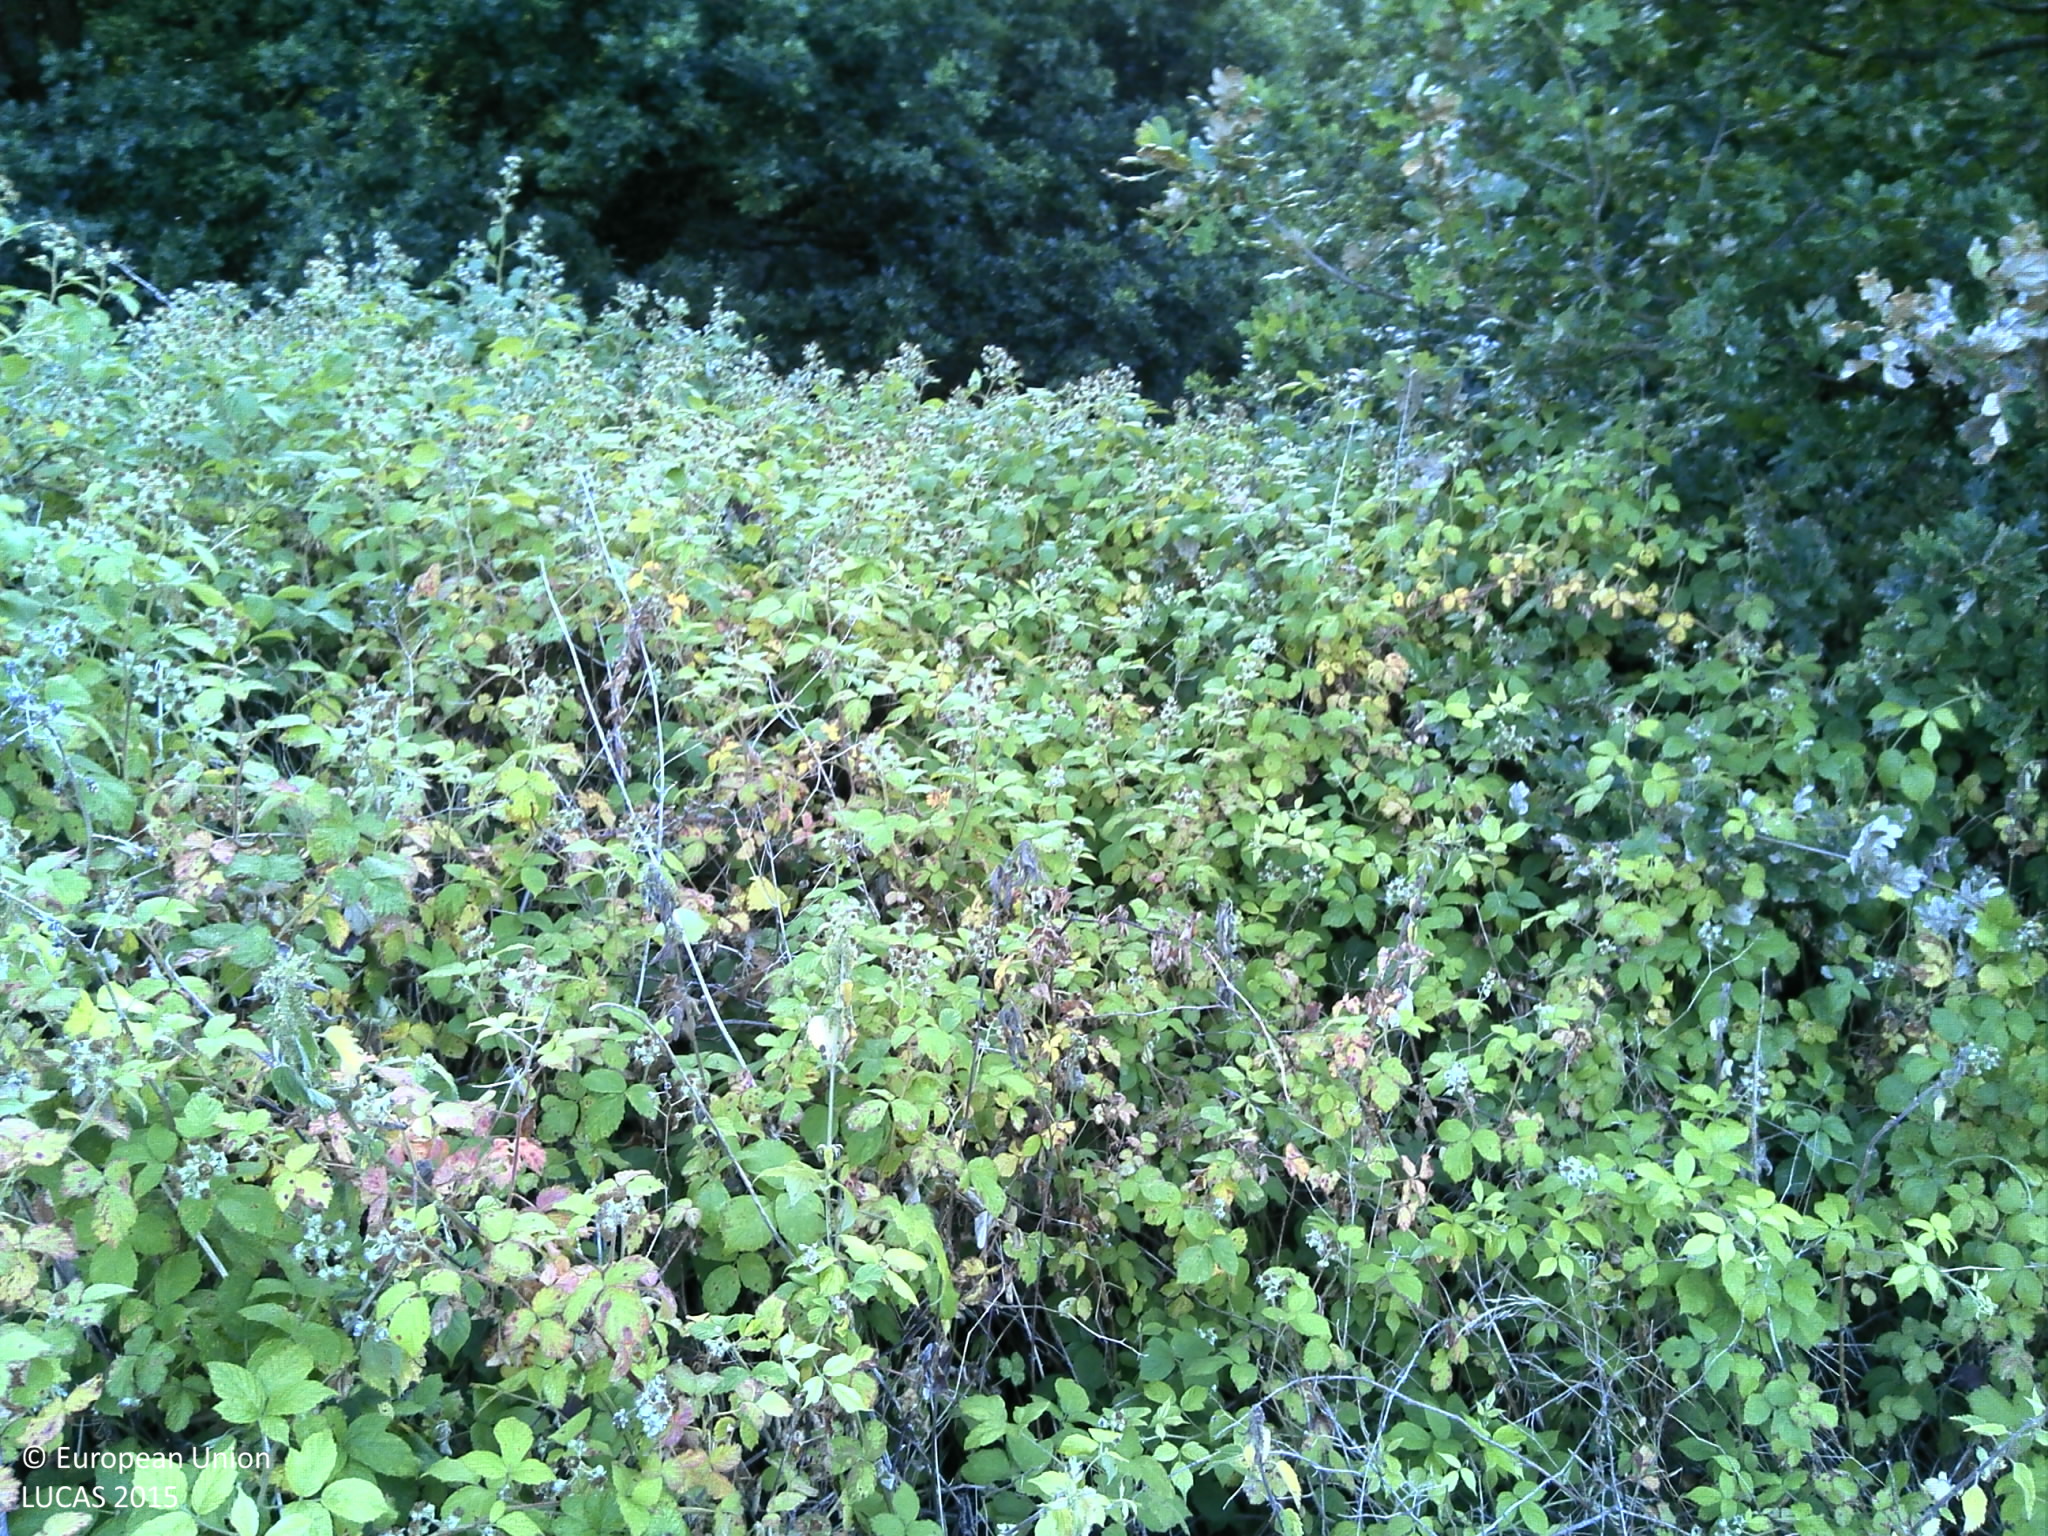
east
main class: Woodland
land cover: Broadleaved woodland
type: acidophilous oak and oak-birch forest
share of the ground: > 75 %
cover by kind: broadleaved forest trees 100 %
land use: Forestry
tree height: > 5 m
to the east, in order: Broadleaved woodland; Paved roads, cycling and walking lanes; Broadleaved woodland; Fences; Broadleaved woodland; Fences; Paved roads, cycling and walking lanes; Grass margins; Sugar beet; Broadleaved woodland
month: June
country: FR
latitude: 49.2893
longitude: 1.0554
